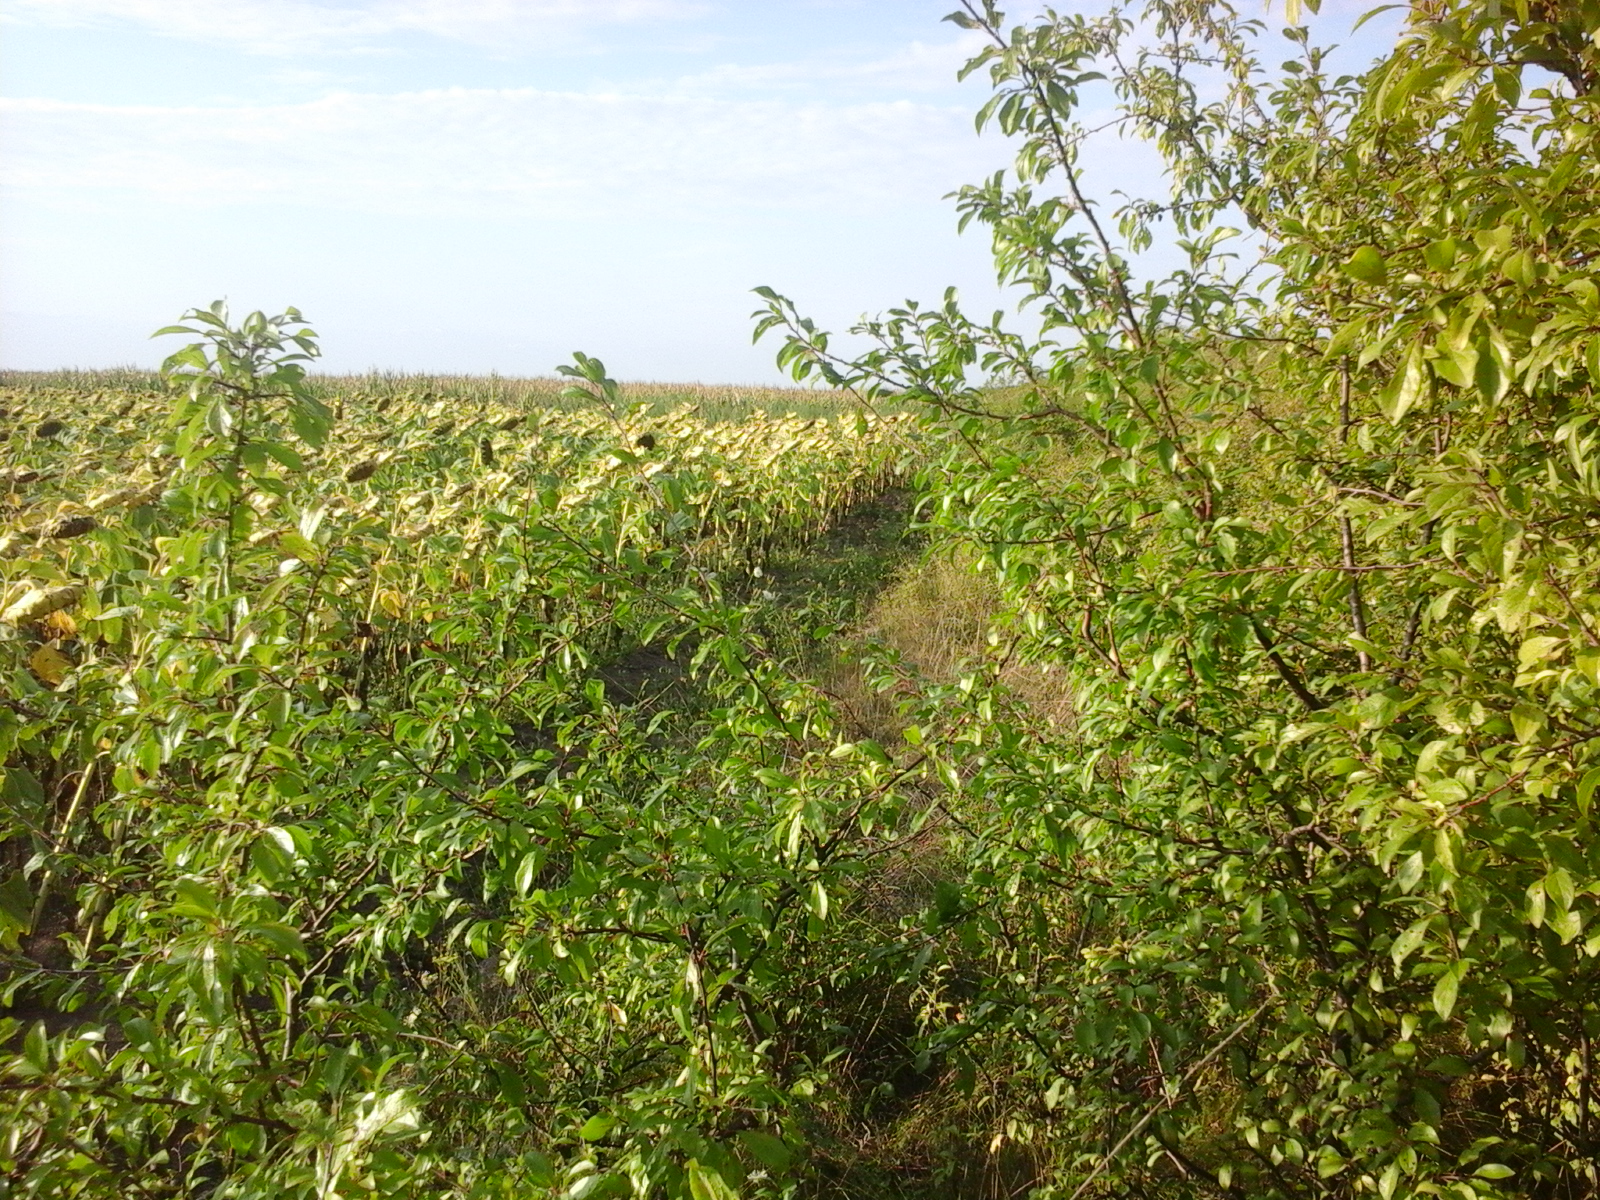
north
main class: Shrubland
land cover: Shrubland without tree cover
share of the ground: > 75 %
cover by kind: shrubs 100 %
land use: Railway transport
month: August
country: RO
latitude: 46.7011
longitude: 21.5883
